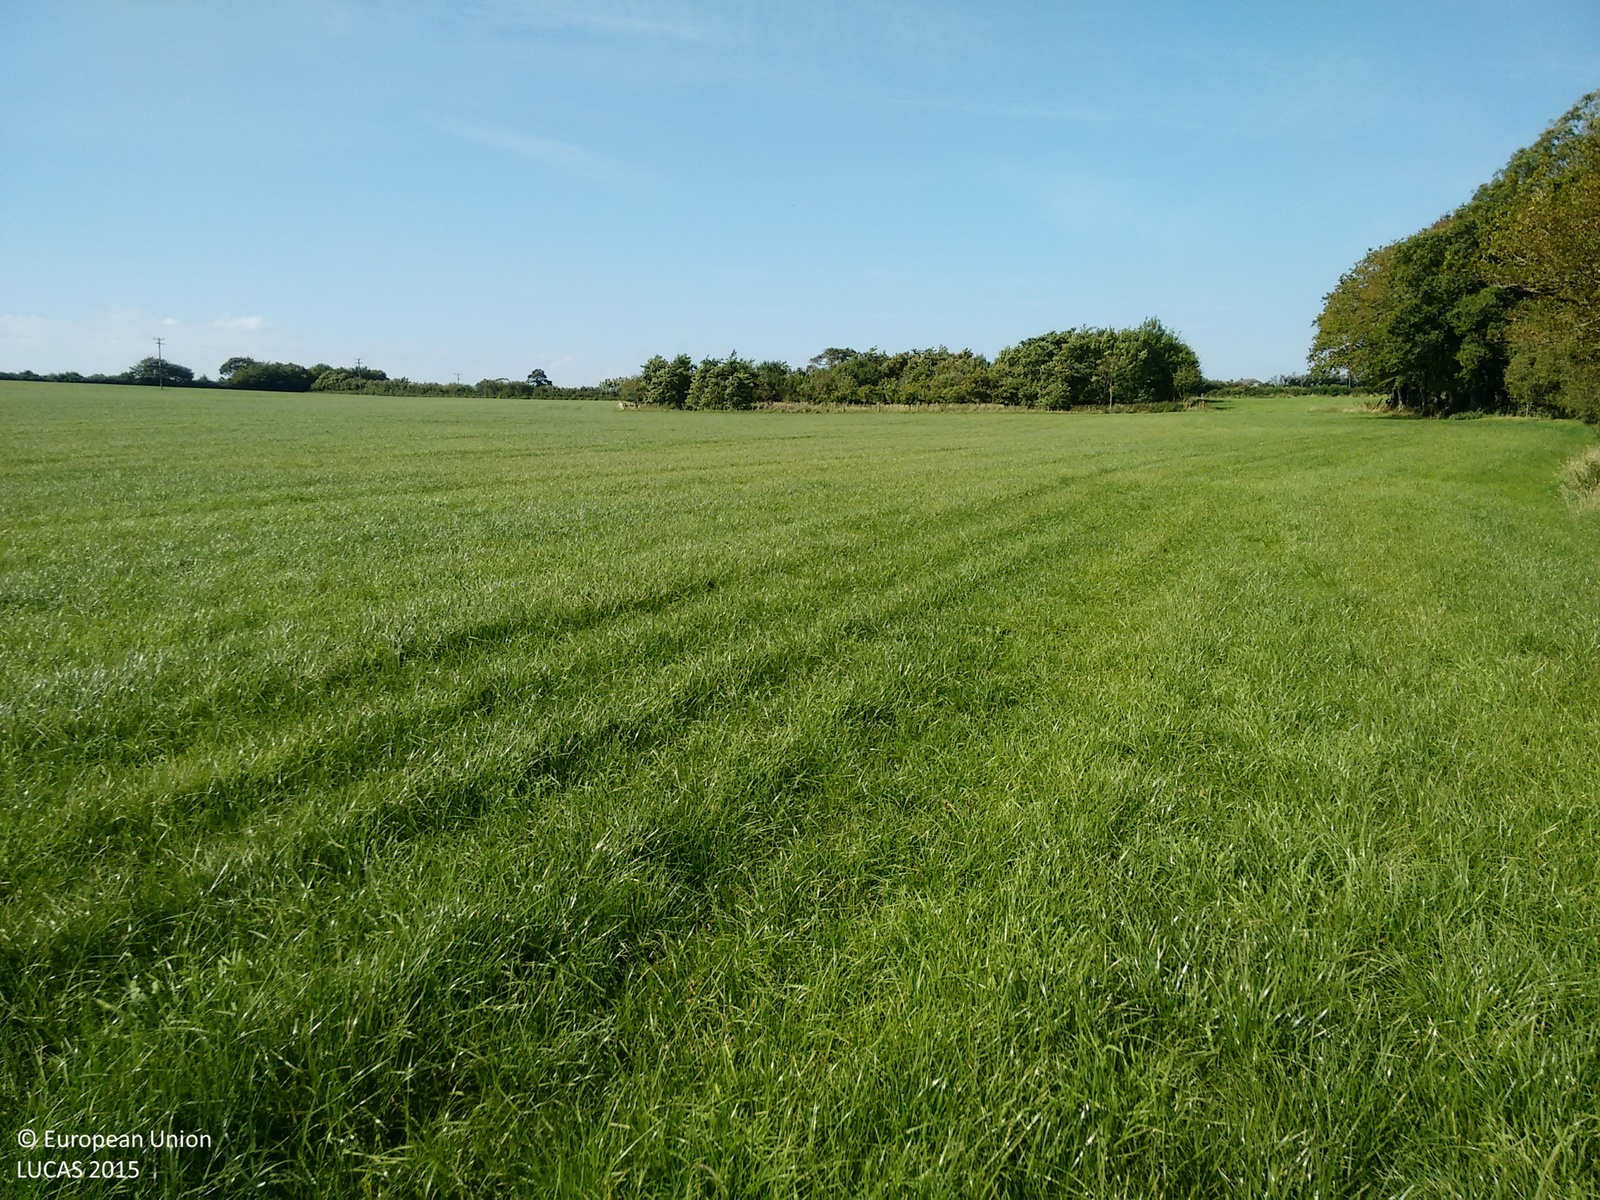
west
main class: Cropland
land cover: Temporary grasslands
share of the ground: > 75 %
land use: Agriculture (excluding fallow land and kitchen gardens)
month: September
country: GB
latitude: 50.8596
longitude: -4.2058
